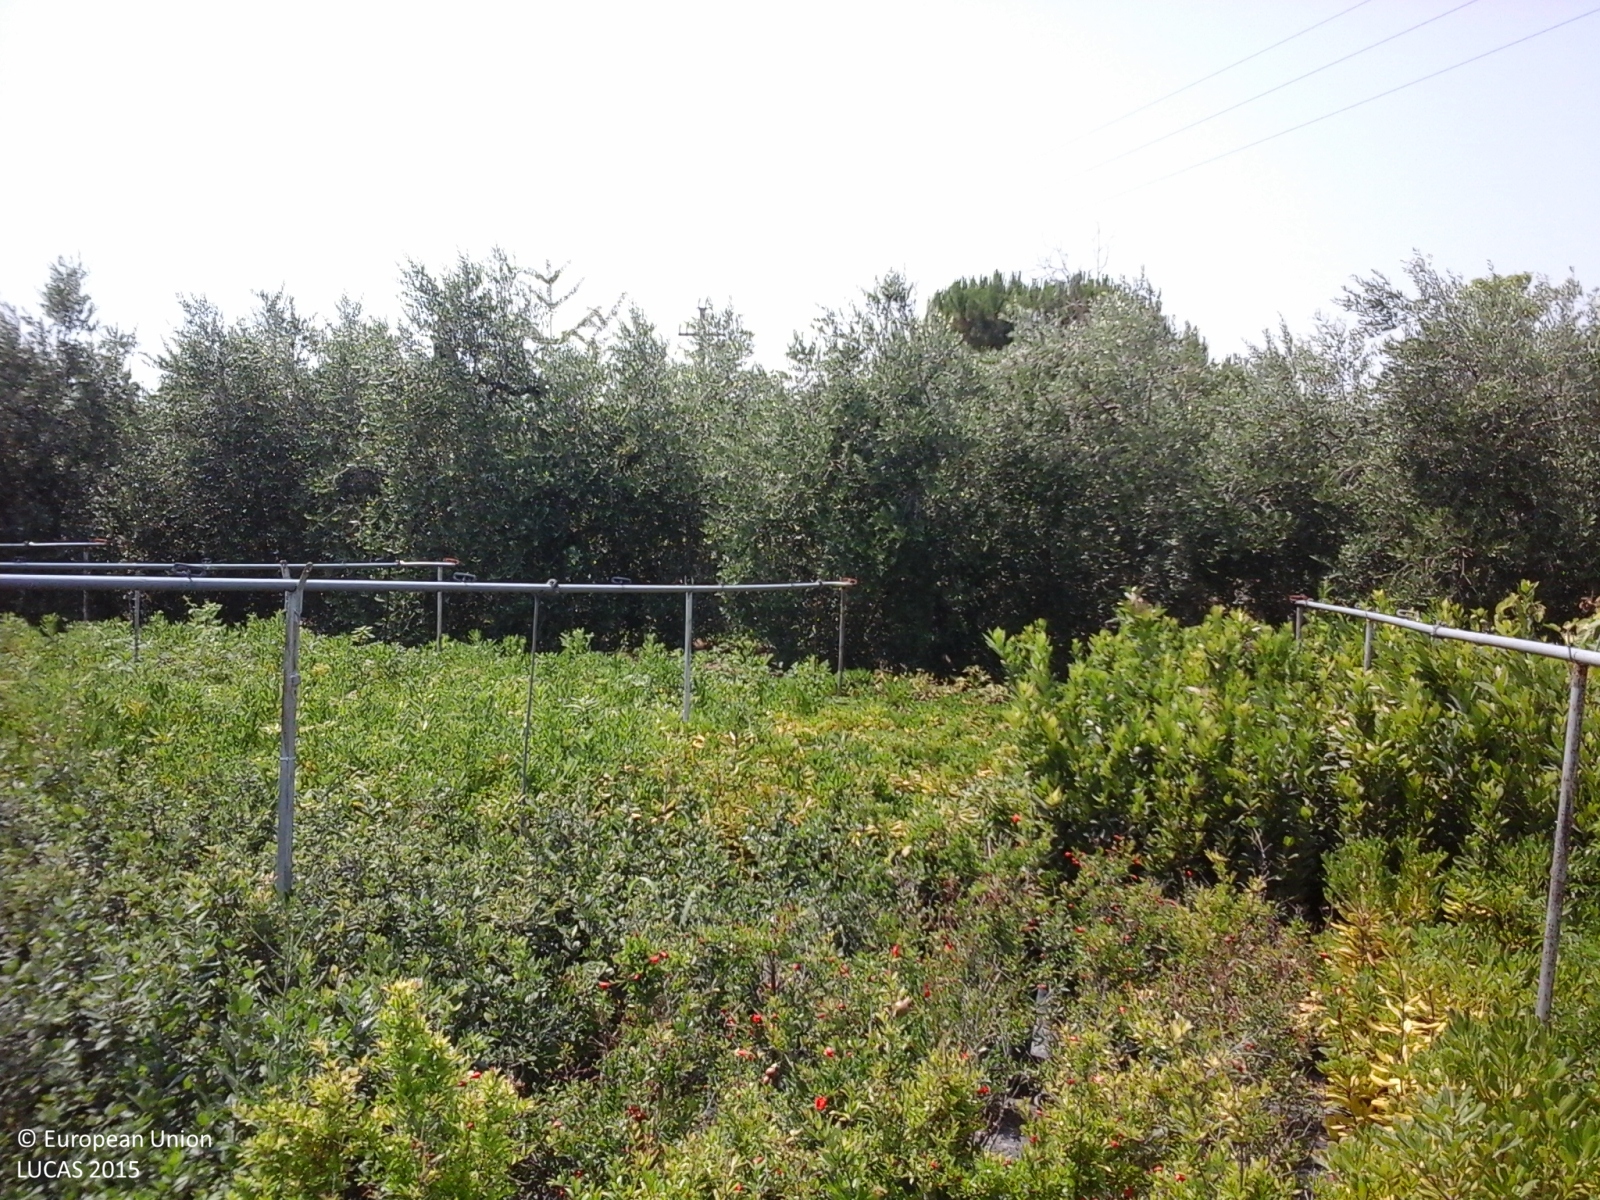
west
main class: Cropland
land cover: Nurseries
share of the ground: > 75 %
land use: Agriculture (excluding fallow land and kitchen gardens)
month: July
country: IT
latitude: 43.0344
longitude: 13.8070
